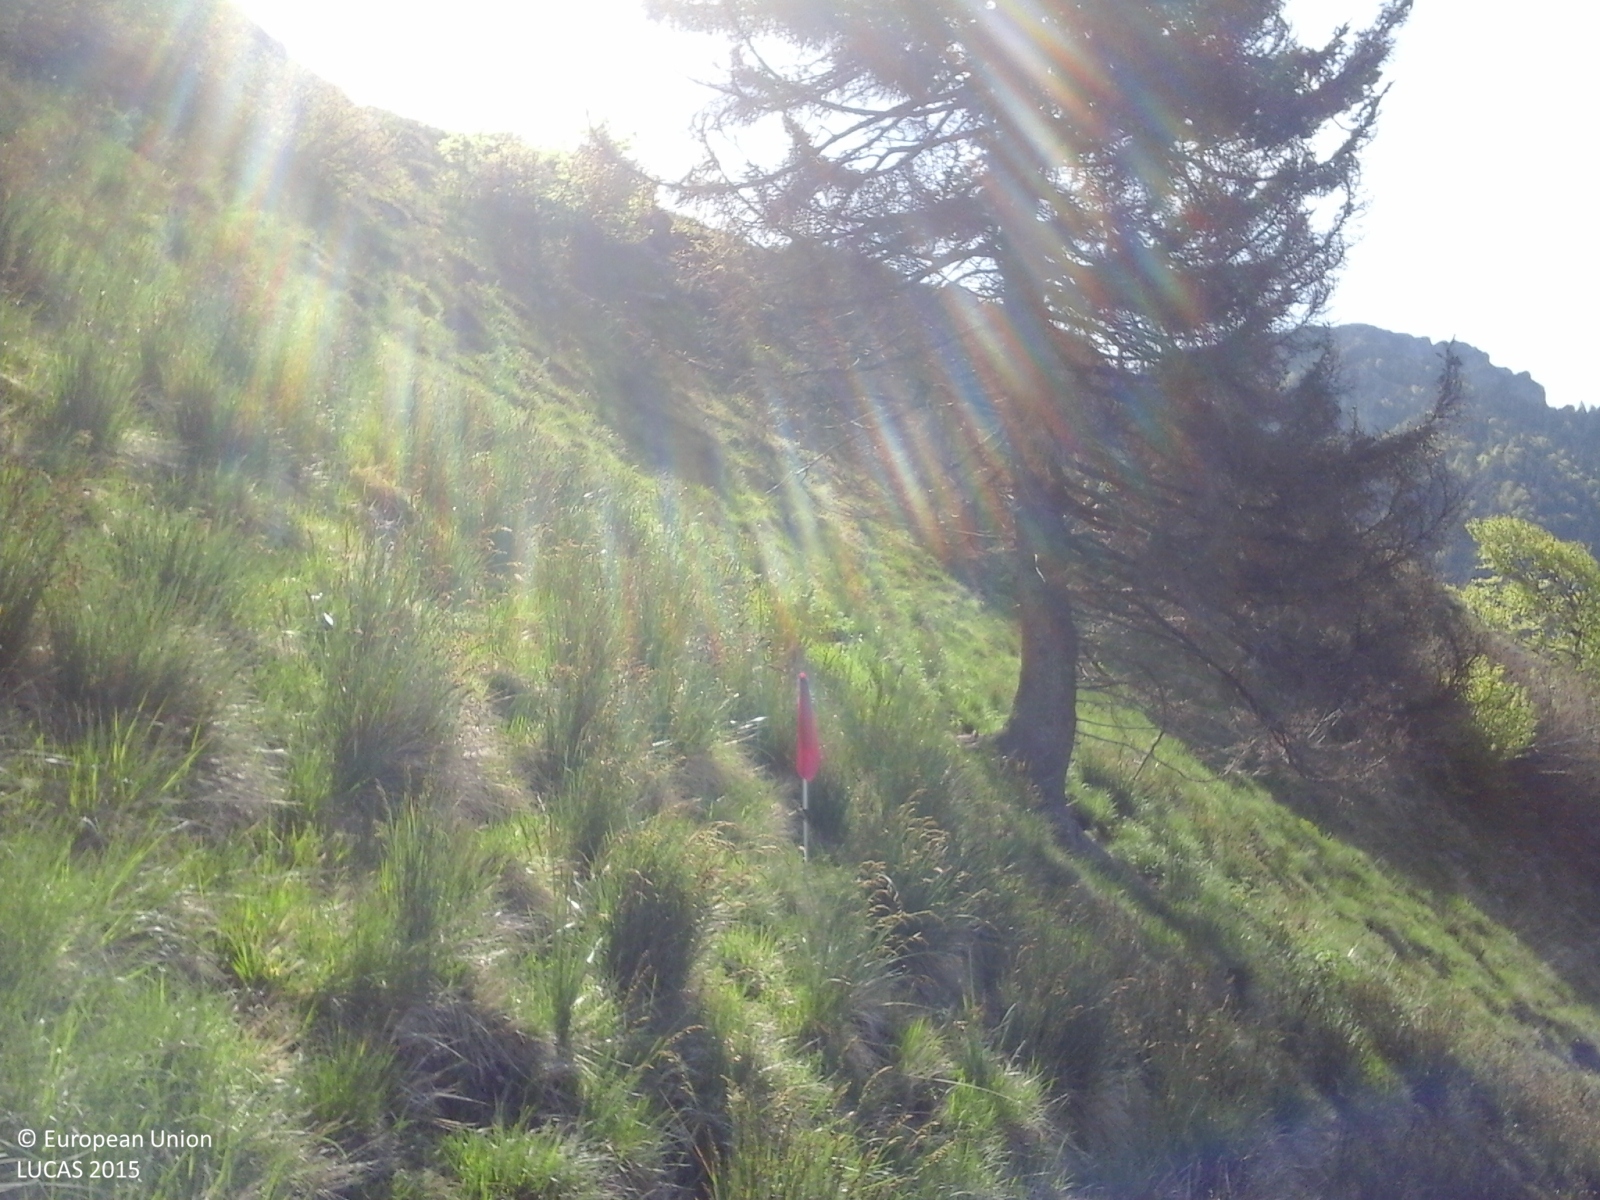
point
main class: Grassland
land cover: Grassland with sparse tree/shrub cover
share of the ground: > 75 %
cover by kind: herbaceous plants 90 %, coniferous forest trees 5 %, shrubs 5 %
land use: Agriculture (excluding fallow land and kitchen gardens)
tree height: > 5 m
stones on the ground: < 10 %
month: May
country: IT
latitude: 45.8092
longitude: 10.5782
